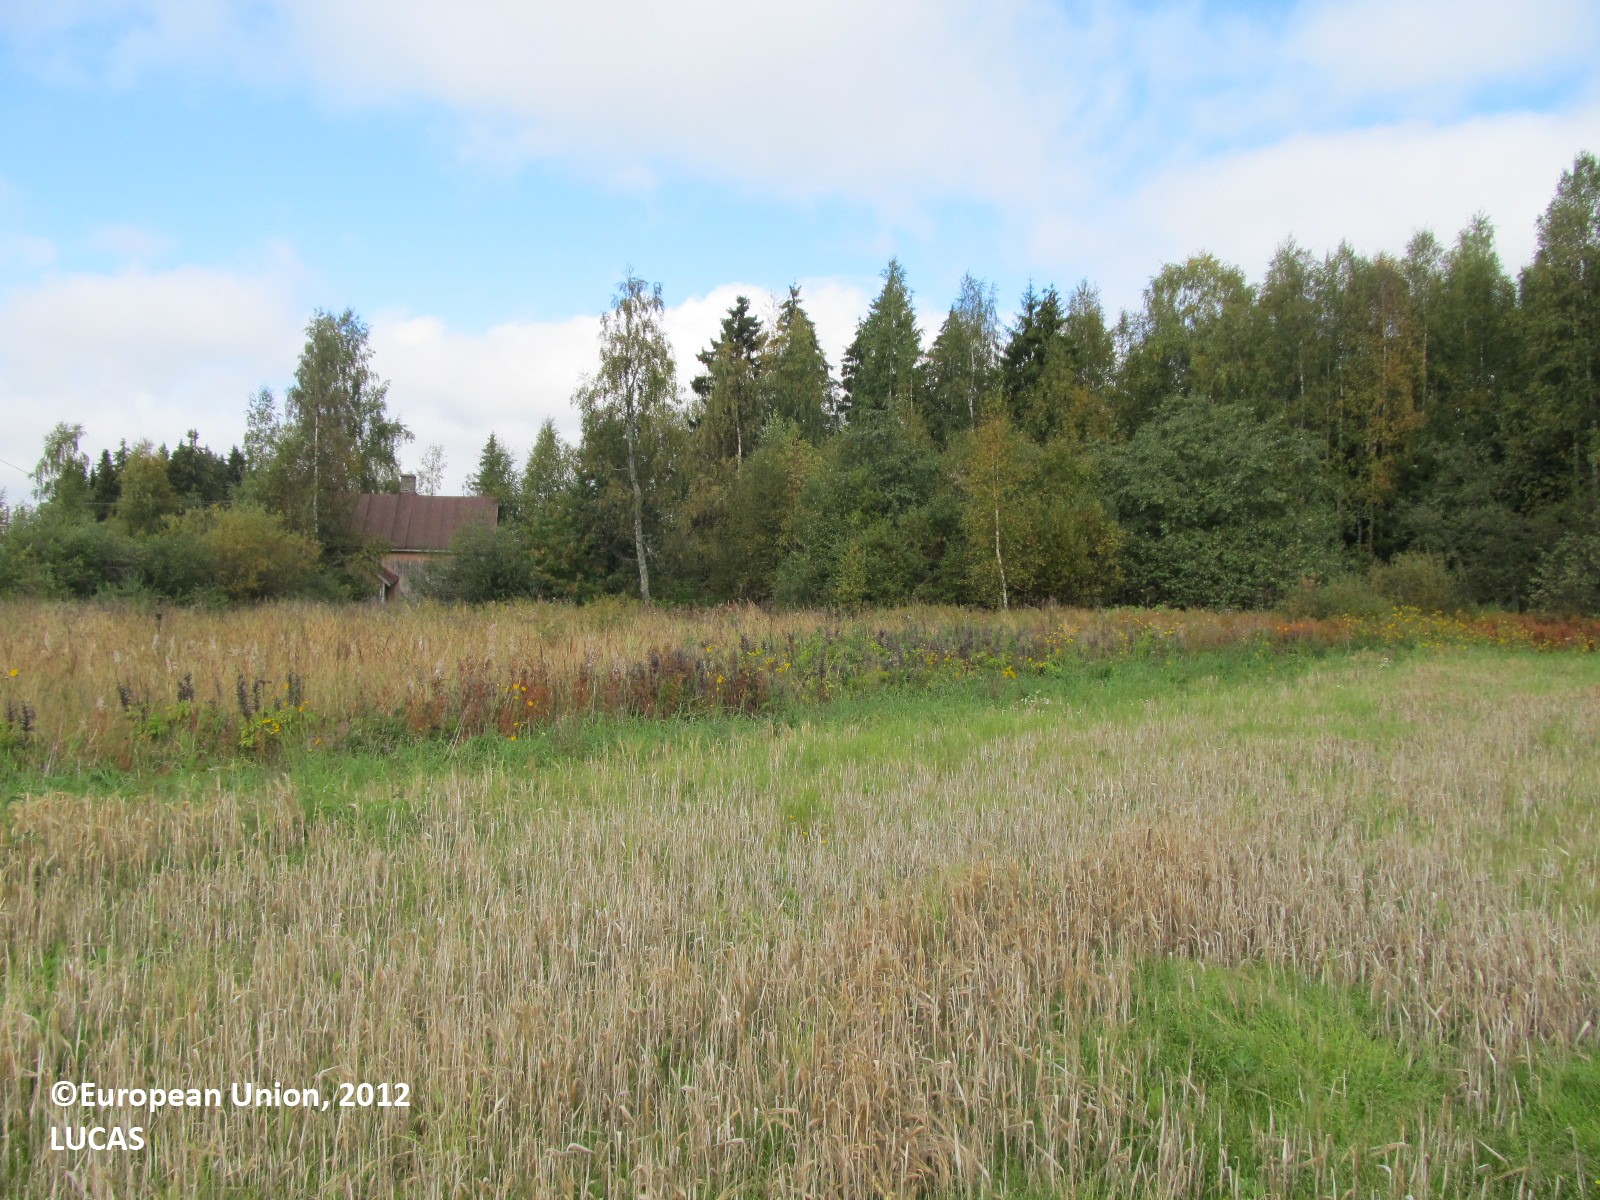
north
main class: Cropland
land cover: Barley
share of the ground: 25 - 50 %
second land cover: Grassland without tree/shrub cover
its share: 50 - 75 %
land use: Agriculture (excluding fallow land and kitchen gardens)
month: September
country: FI
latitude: 62.9376
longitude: 28.2130
